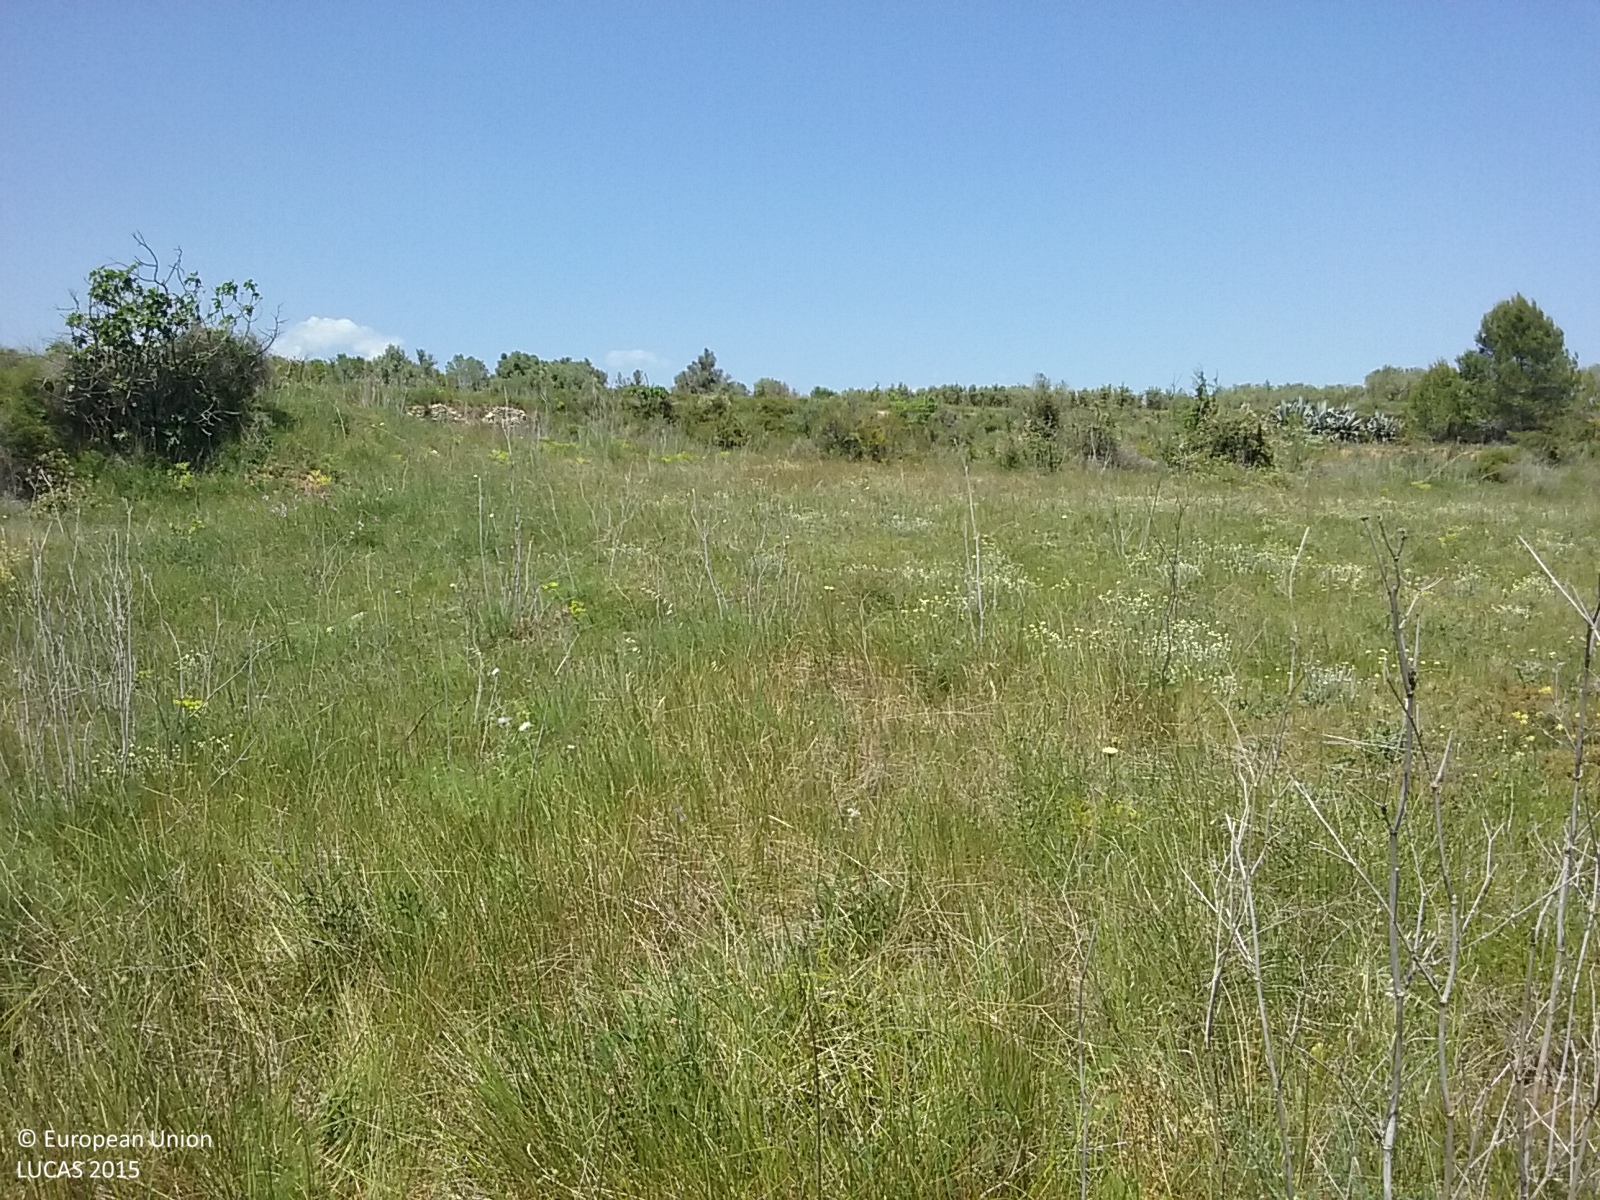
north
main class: Grassland
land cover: Grassland with sparse tree/shrub cover
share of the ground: > 75 %
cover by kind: herbaceous plants 90 %, broadleaved forest trees 5 %, shrubs 5 %
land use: Abandoned areas
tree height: > 5 m
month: May
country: ES
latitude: 40.5457
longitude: 0.2536
